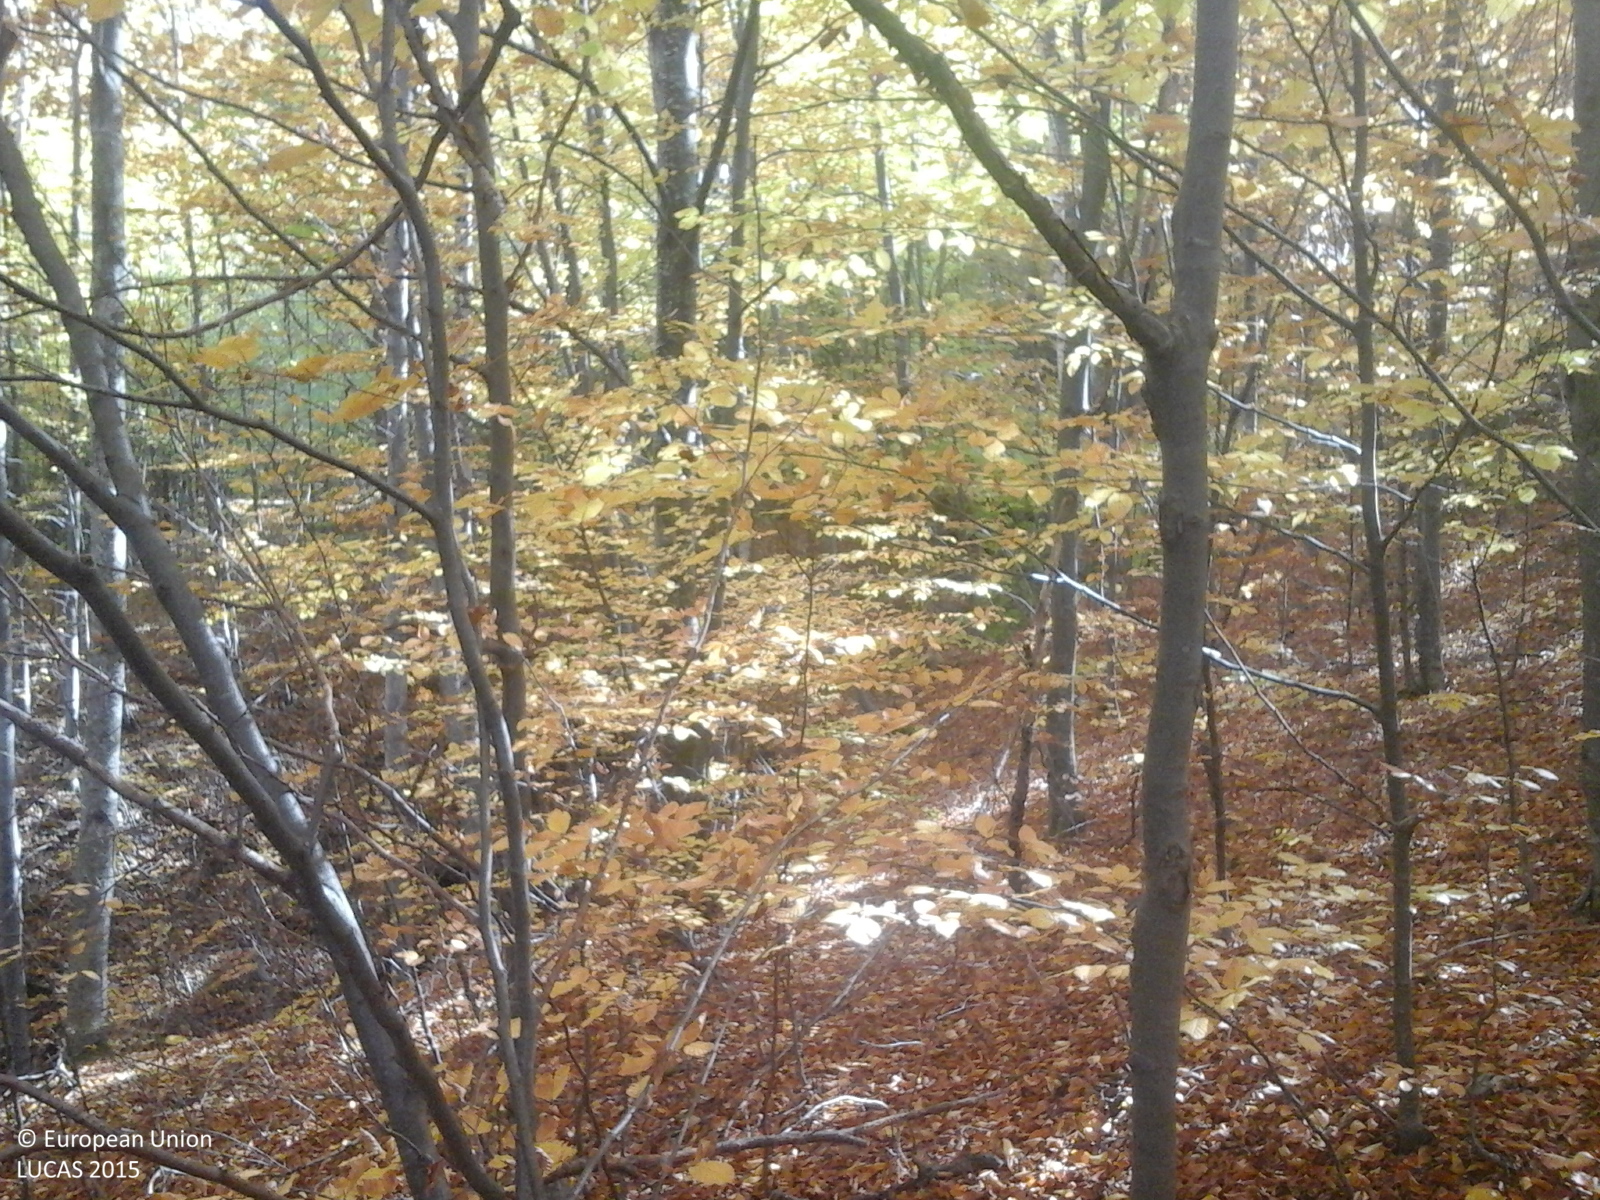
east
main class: Woodland
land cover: Broadleaved woodland
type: beech forest
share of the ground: > 75 %
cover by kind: broadleaved forest trees 100 %
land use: Forestry
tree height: > 5 m
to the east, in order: Broadleaved woodland; Grassland with sparse tree/shrub cover; Broadleaved woodland; Grassland with sparse tree/shrub cover
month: October
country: RO
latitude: 45.9246
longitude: 26.5988
